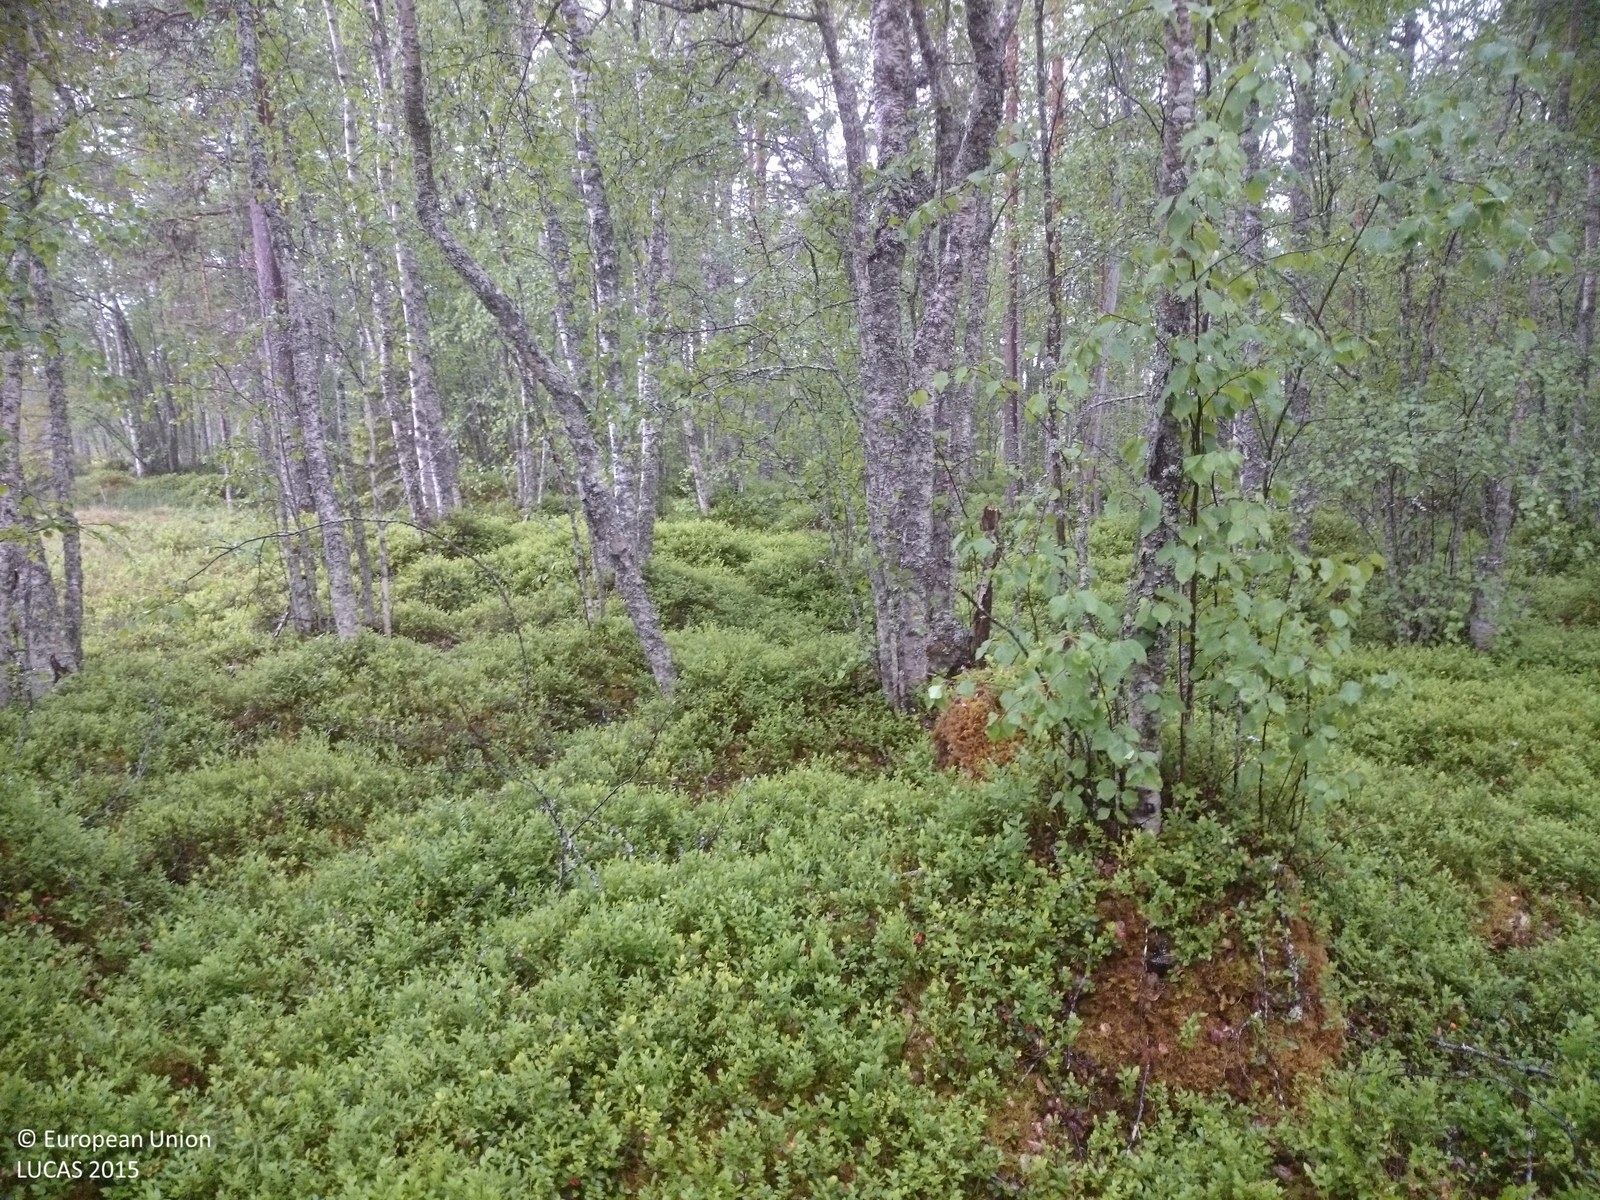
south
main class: Woodland
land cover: Broadleaved woodland
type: hemiboreal forest and nemoral coniferous forest and mixed broadleaved-coniferous forest
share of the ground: 25 - 50 %
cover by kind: shrubs 60 %, broadleaved forest trees 30 %, lichens and mosses 10 %
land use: Semi-natural and natural areas not in use
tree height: > 5 m
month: June
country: SE
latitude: 62.1029
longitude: 16.2459
